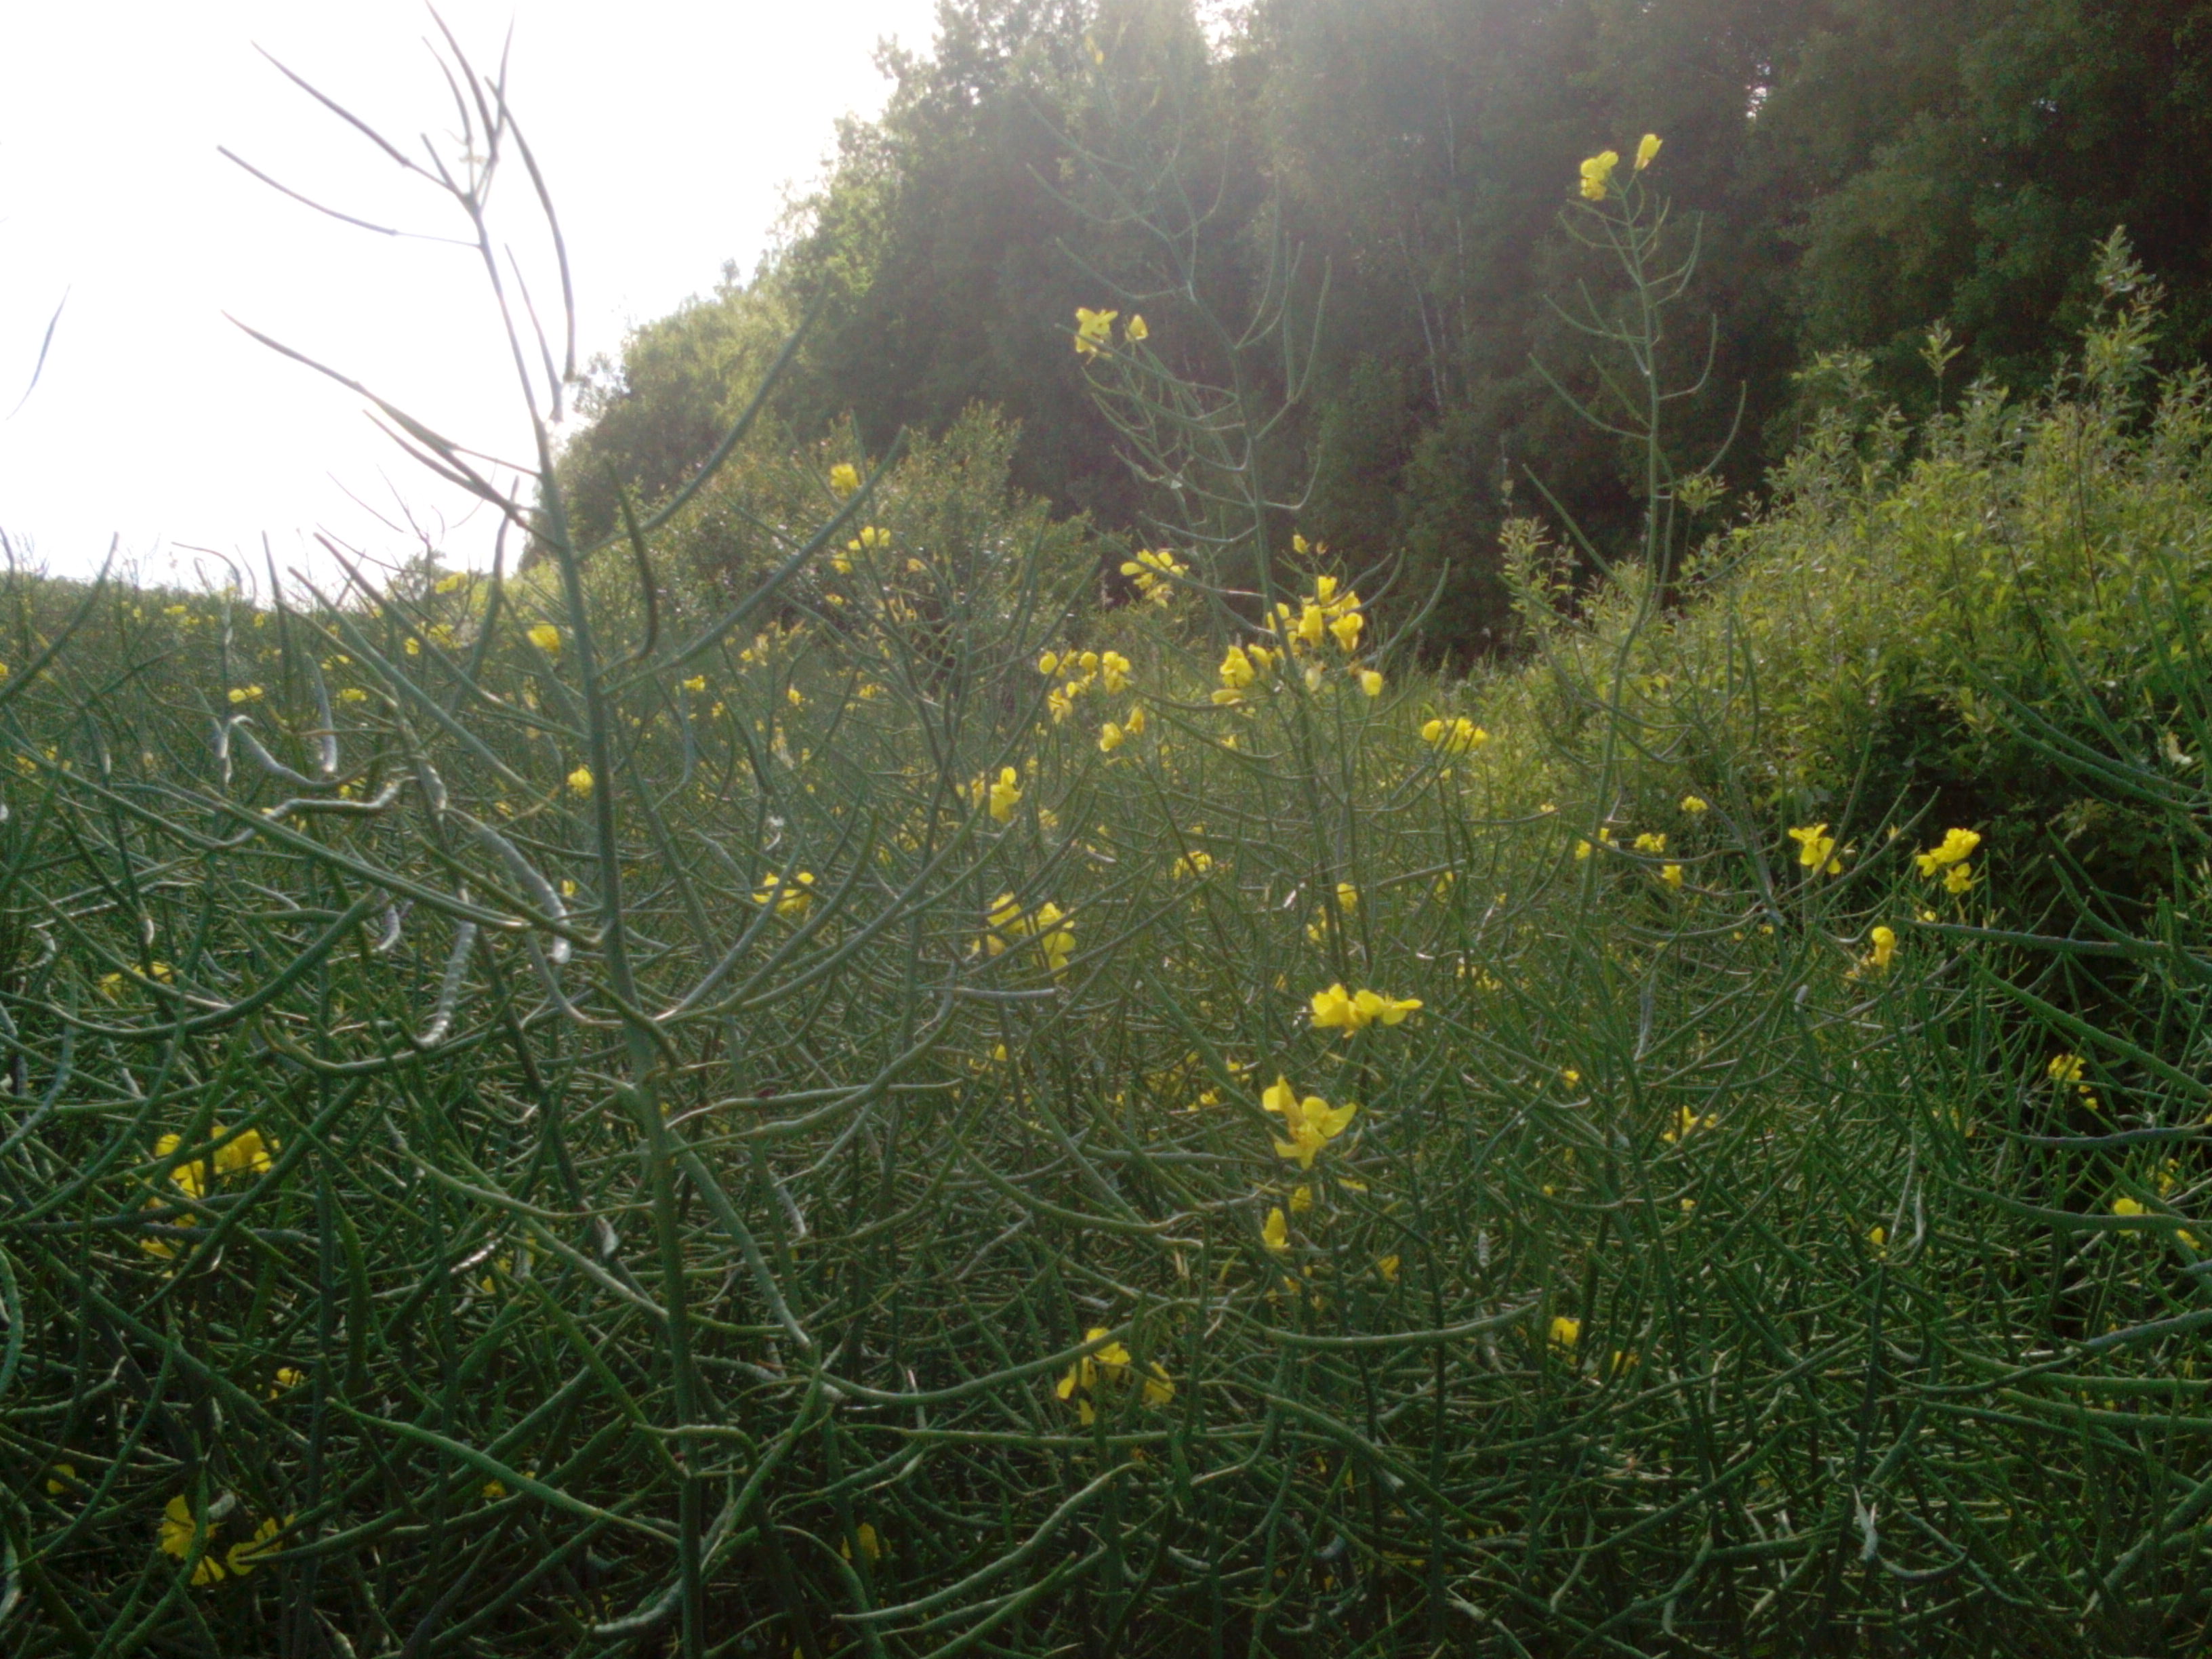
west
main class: Cropland
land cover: Rape and turnip rape
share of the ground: > 75 %
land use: Agriculture (excluding fallow land and kitchen gardens)
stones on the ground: < 10 %
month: June
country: LV
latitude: 56.6940
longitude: 22.2169
